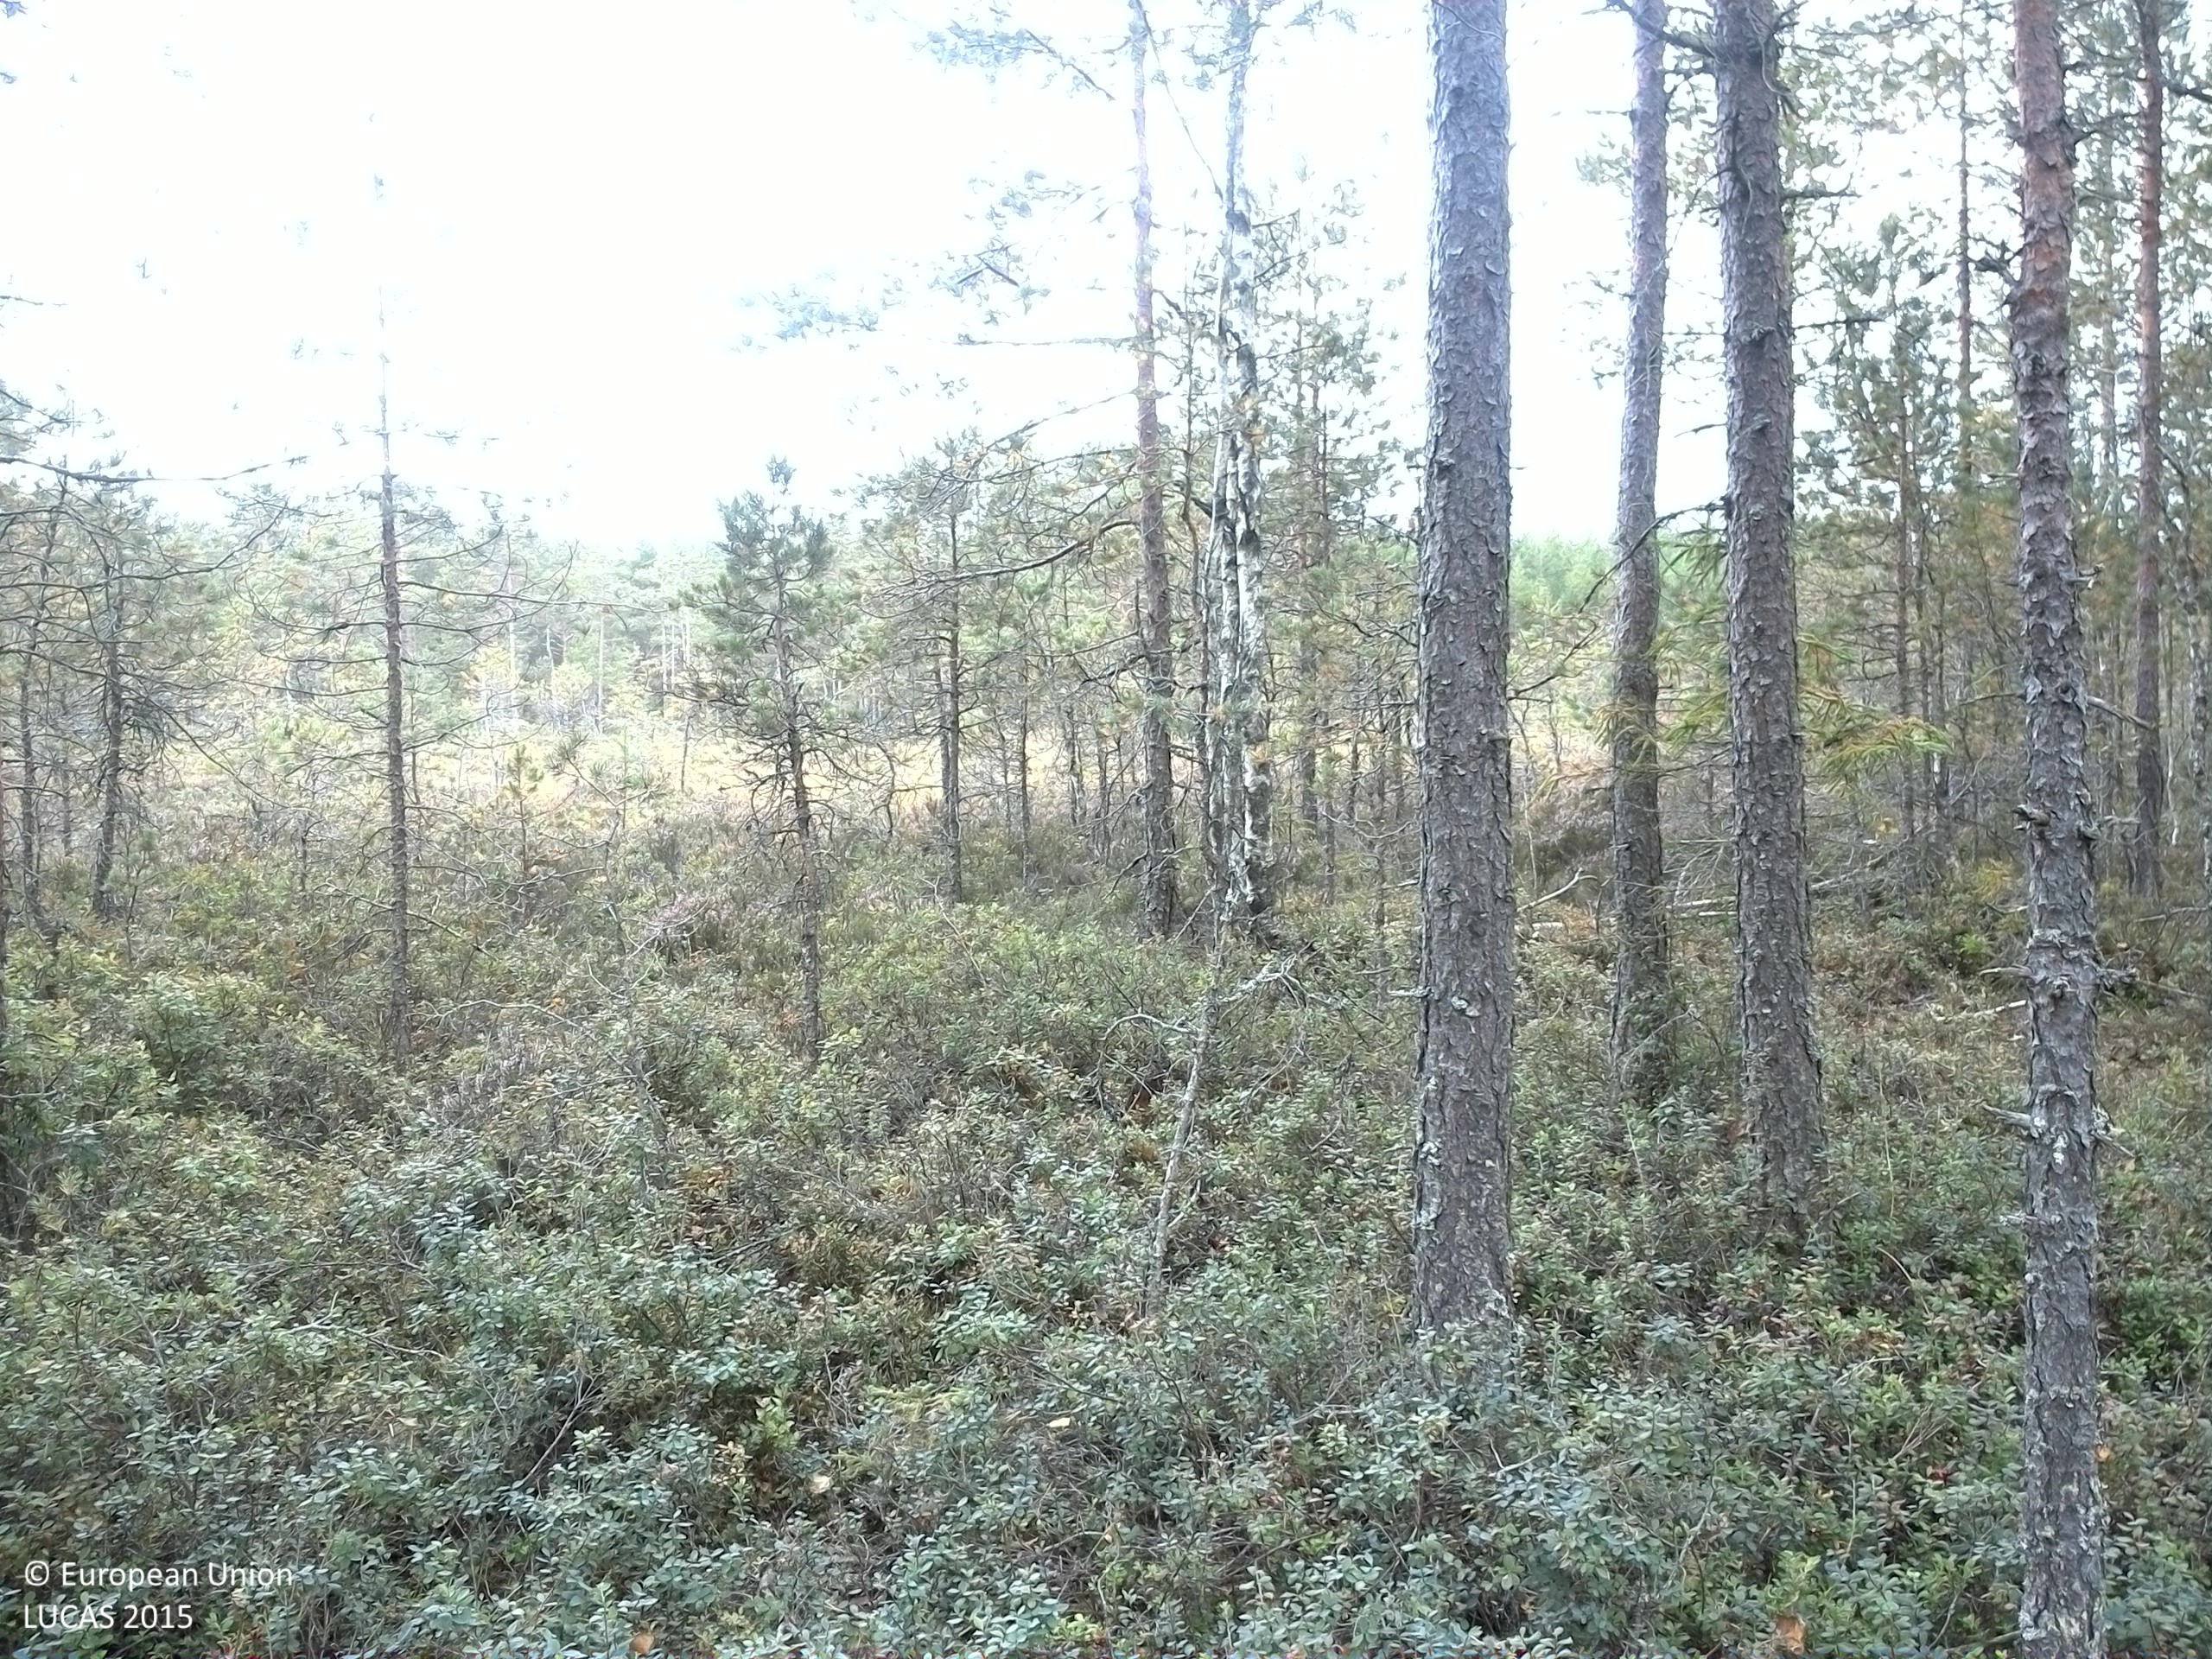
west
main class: Woodland
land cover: Pine dominated mixed woodland
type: boreal forest
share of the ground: 50 - 75 %
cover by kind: coniferous forest trees 40 %, broadleaved forest trees 25 %, shrubs 25 %, lichens and mosses 10 %
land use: Forestry
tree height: > 5 m
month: September
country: SE
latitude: 59.7983
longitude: 13.3598
